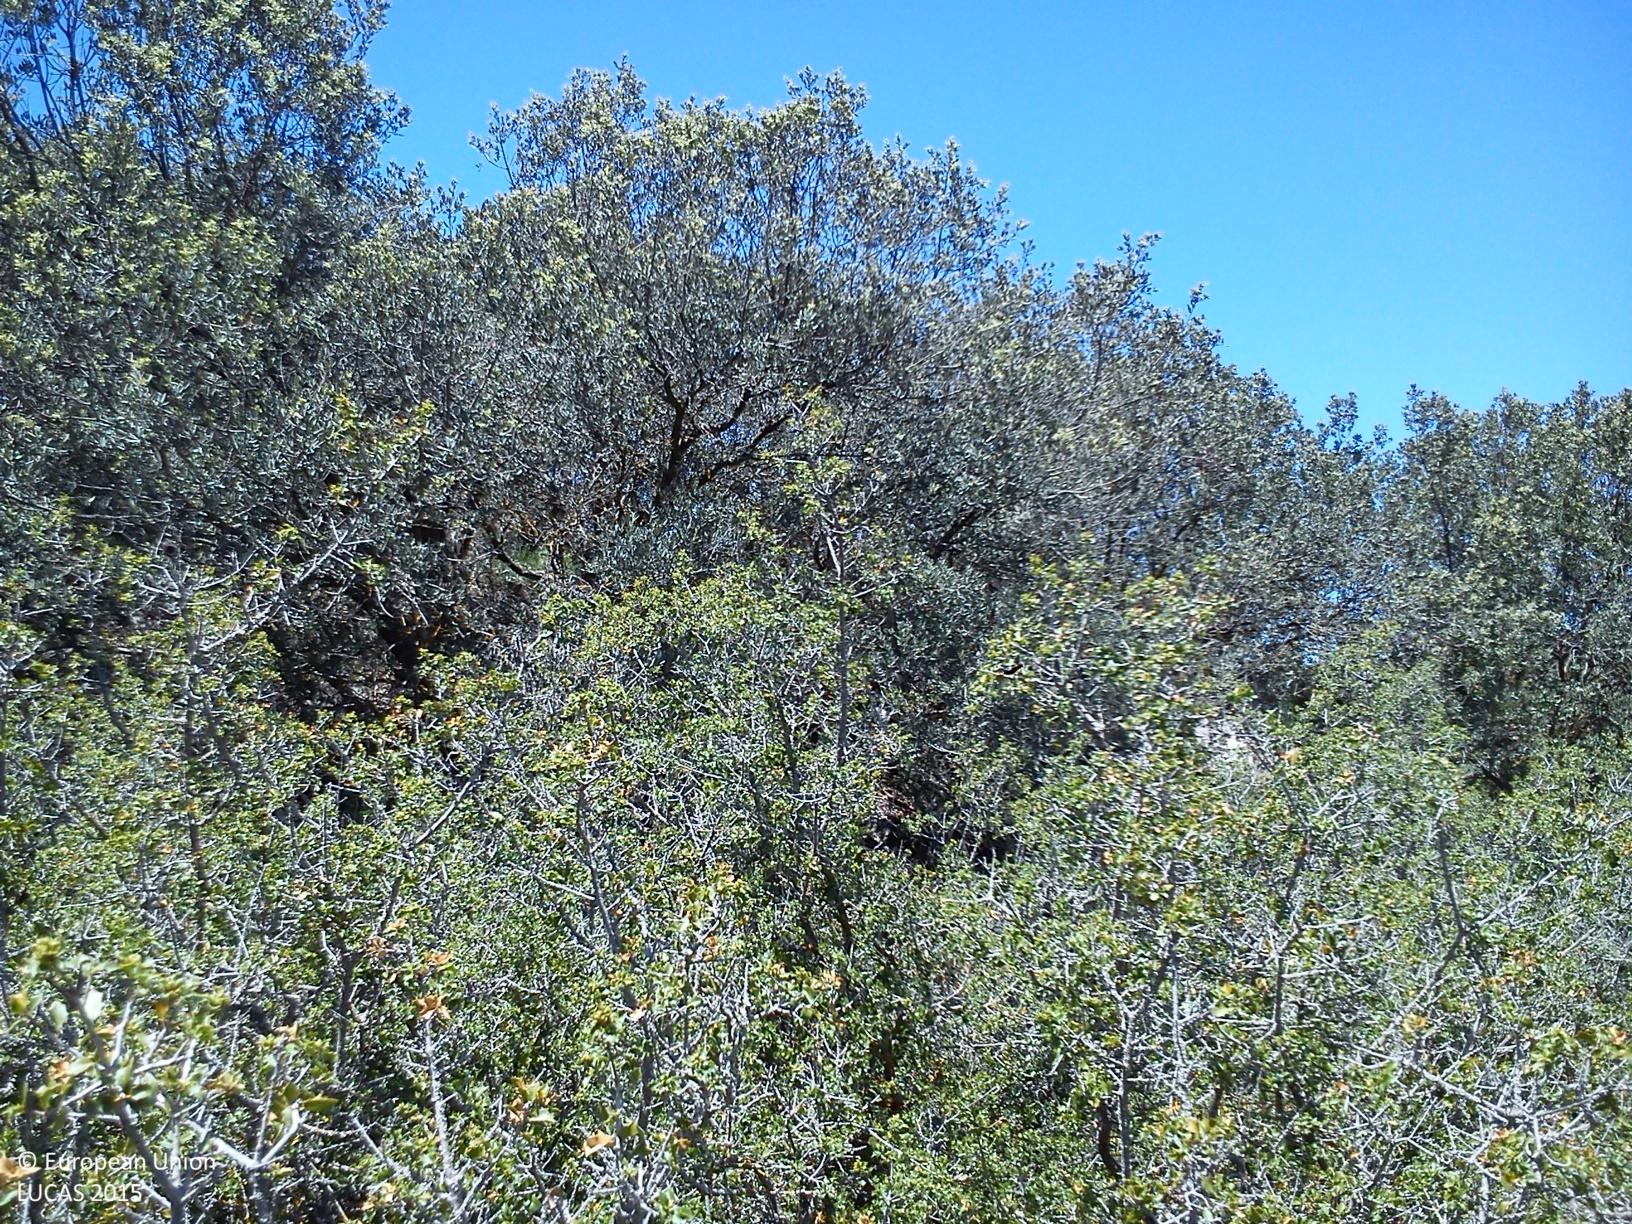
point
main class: Shrubland
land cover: Shrubland with sparse tree cover
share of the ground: > 75 %
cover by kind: shrubs 90 %, coniferous forest trees 5 %, consolidated bare surface 5 %
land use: Semi-natural and natural areas not in use
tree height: < 5 m
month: May
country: ES
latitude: 39.5328
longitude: -0.8787
